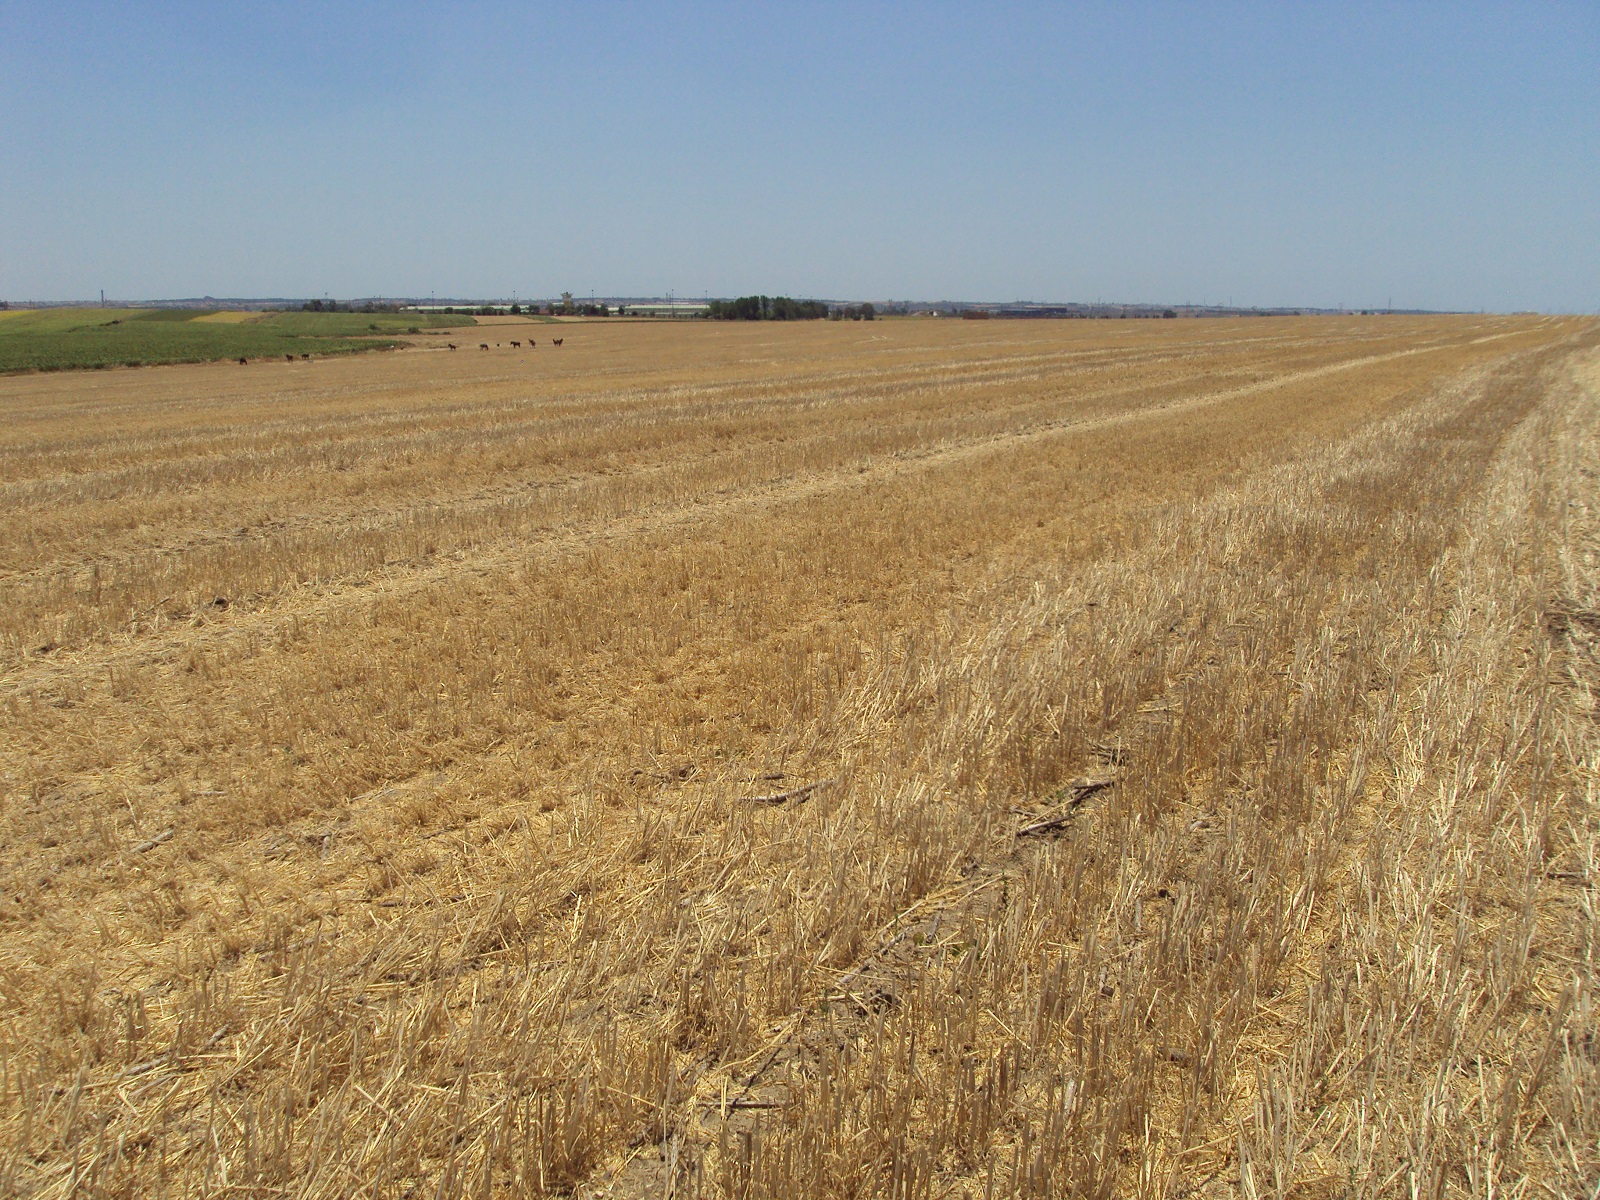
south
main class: Cropland
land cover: Durum wheat
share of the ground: > 75 %
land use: Agriculture (excluding fallow land and kitchen gardens)
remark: Harvested field
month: June
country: ES
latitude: 37.3333
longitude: -6.8893
